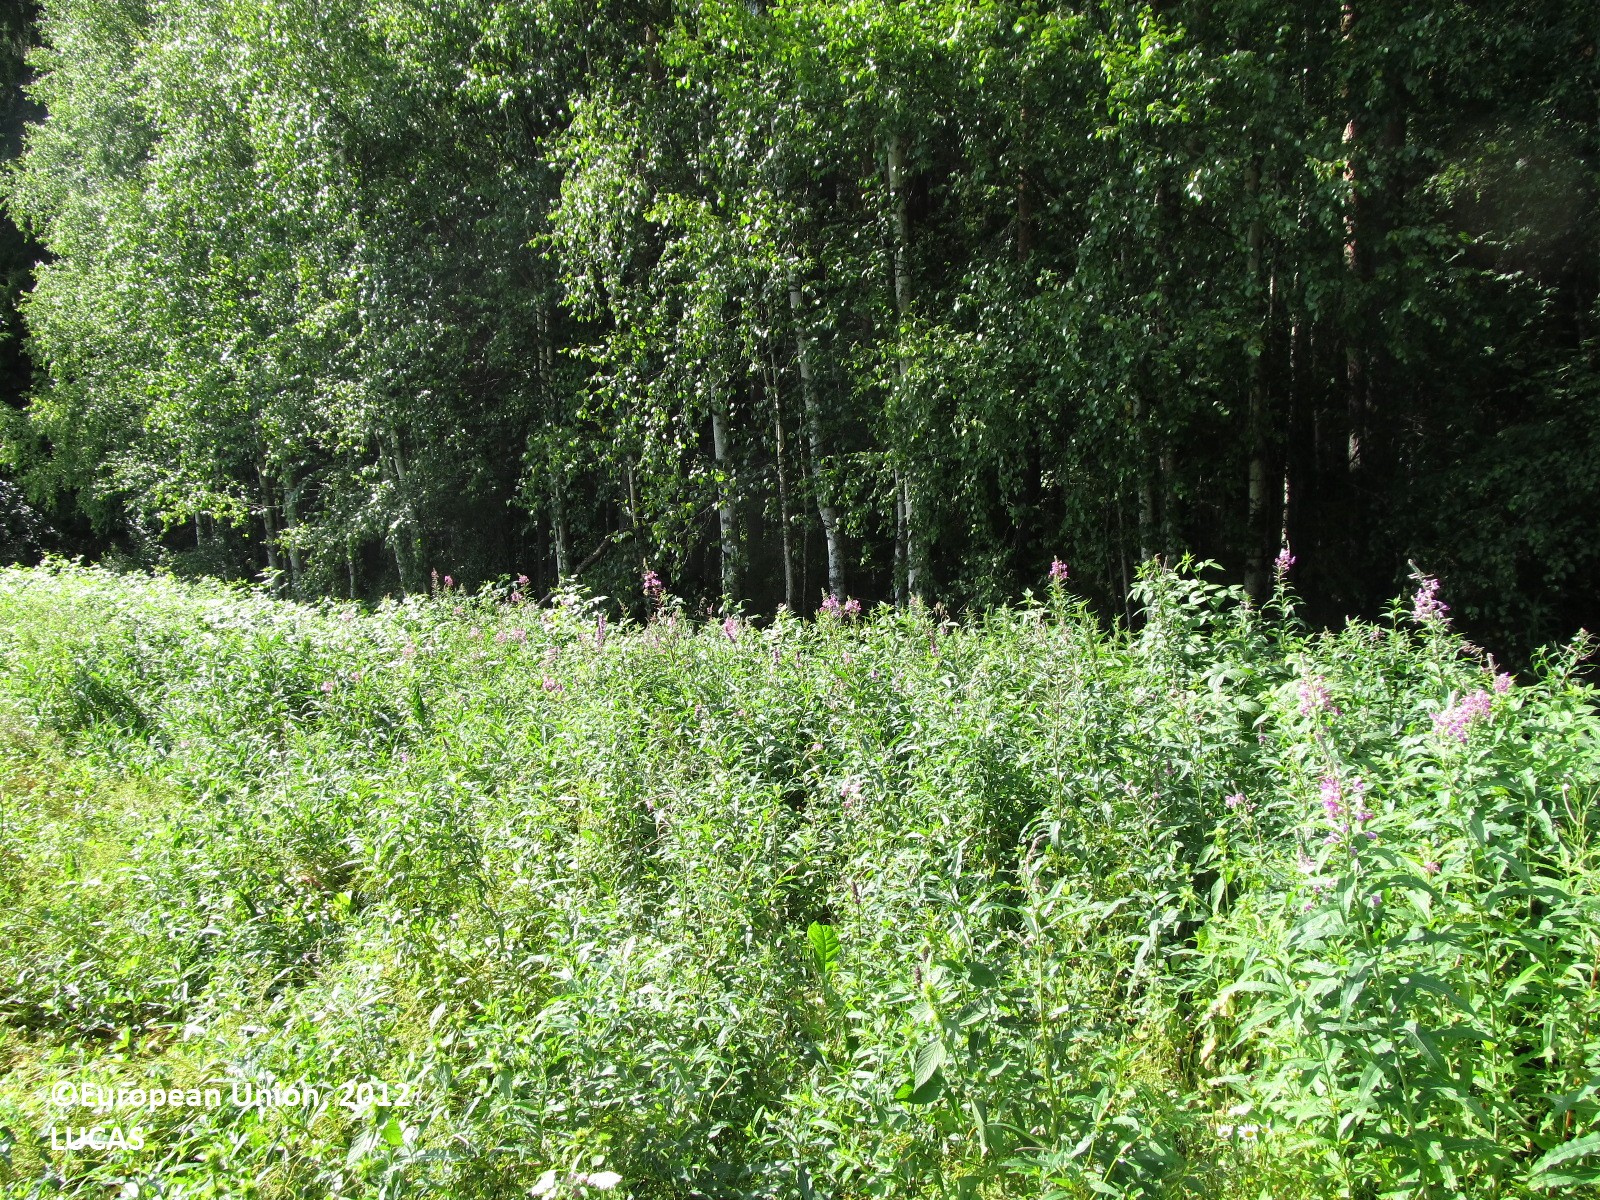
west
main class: Grassland
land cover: Grassland without tree/shrub cover
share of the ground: > 75 %
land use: Fallow land
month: July
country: FI
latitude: 61.9300
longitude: 28.0806
